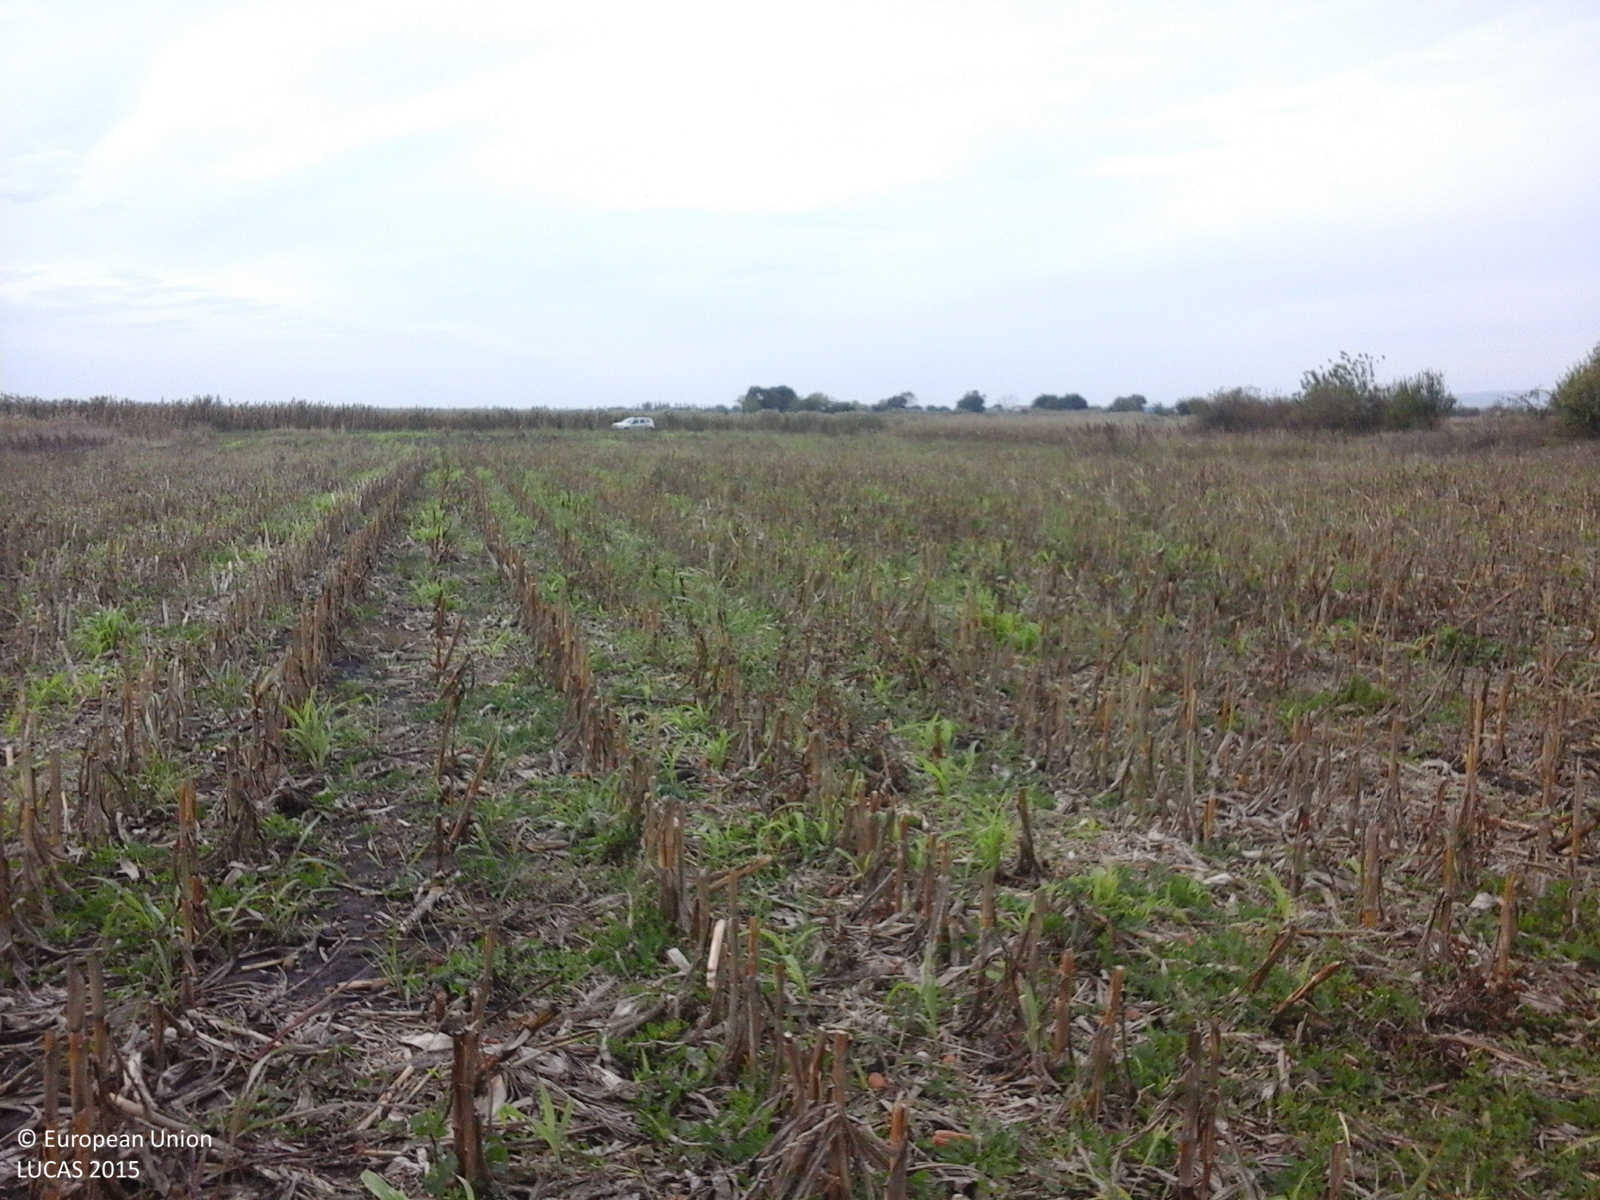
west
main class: Cropland
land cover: Maize
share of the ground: 25 - 50 %
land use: Agriculture (excluding fallow land and kitchen gardens)
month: October
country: RO
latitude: 44.9219
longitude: 26.3186
